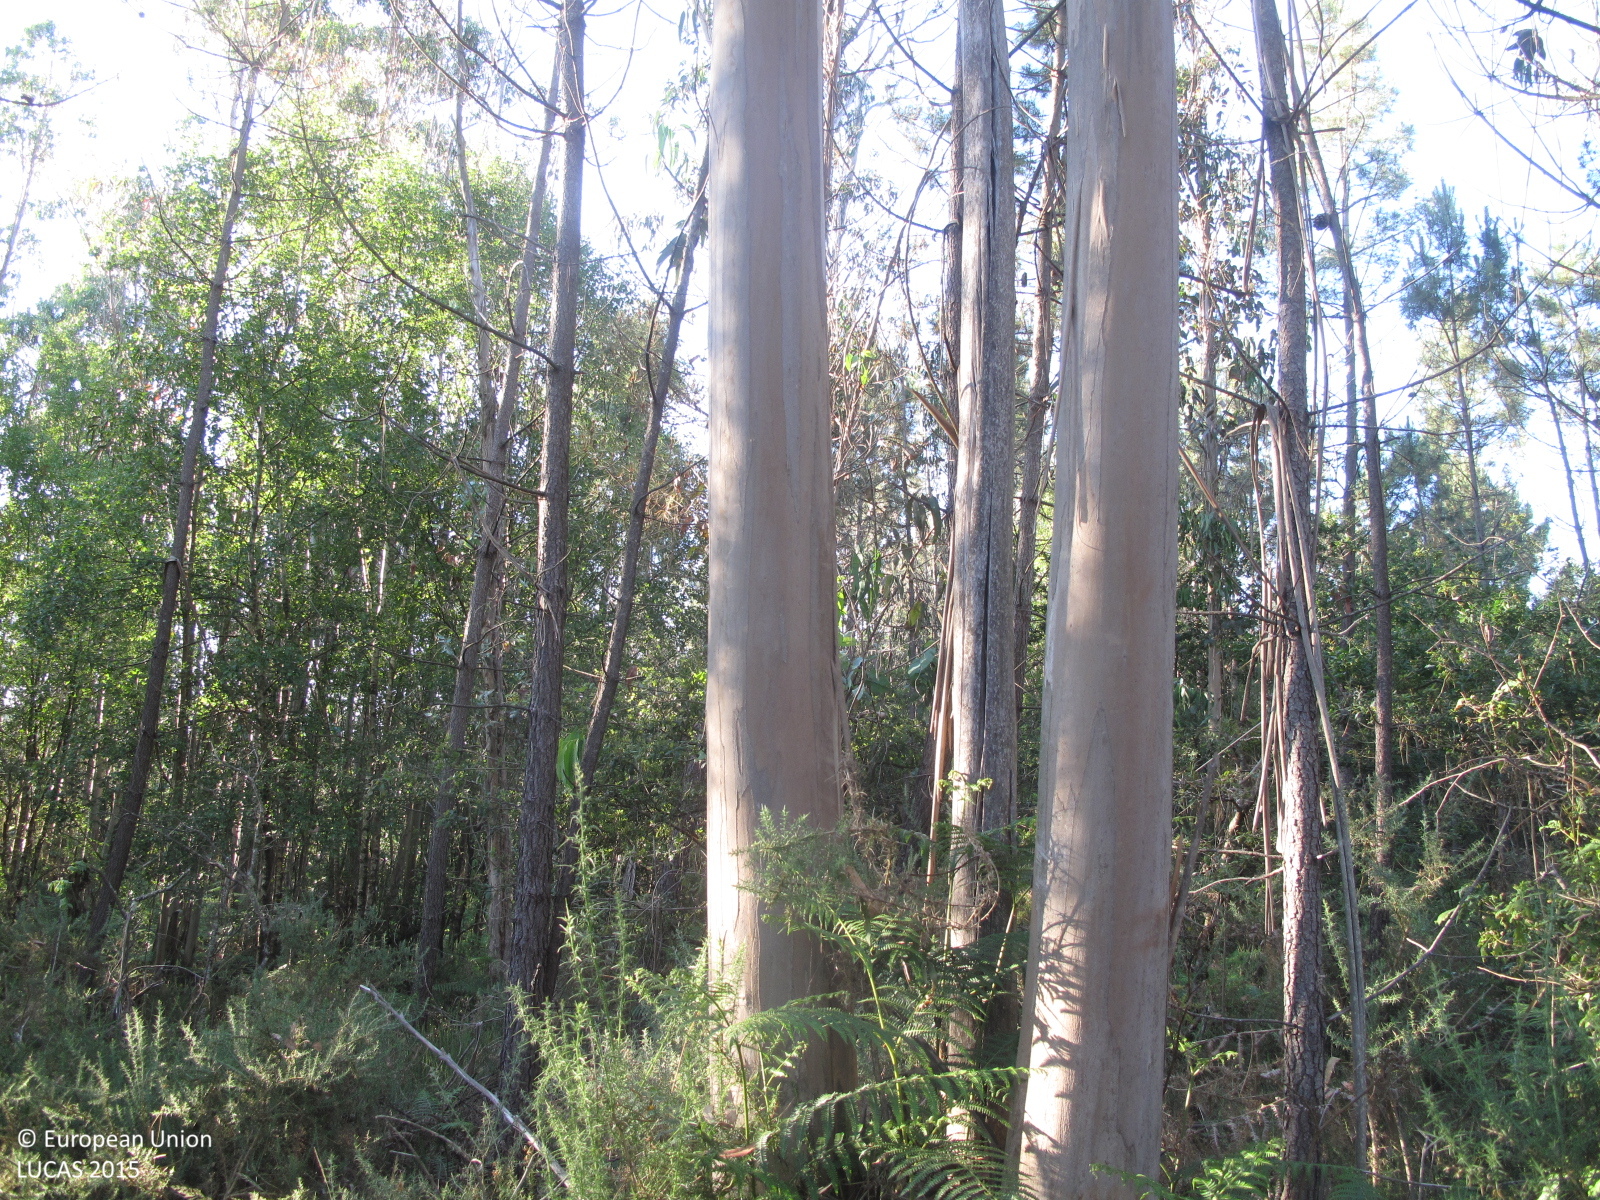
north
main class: Woodland
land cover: Other mixed woodland
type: exotic forest
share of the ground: 50 - 75 %
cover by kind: broadleaved forest trees 40 %, coniferous forest trees 30 %, shrubs 20 %, herbaceous plants 10 %
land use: Forestry
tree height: > 5 m
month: June
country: ES
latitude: 42.9720
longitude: -8.5596
